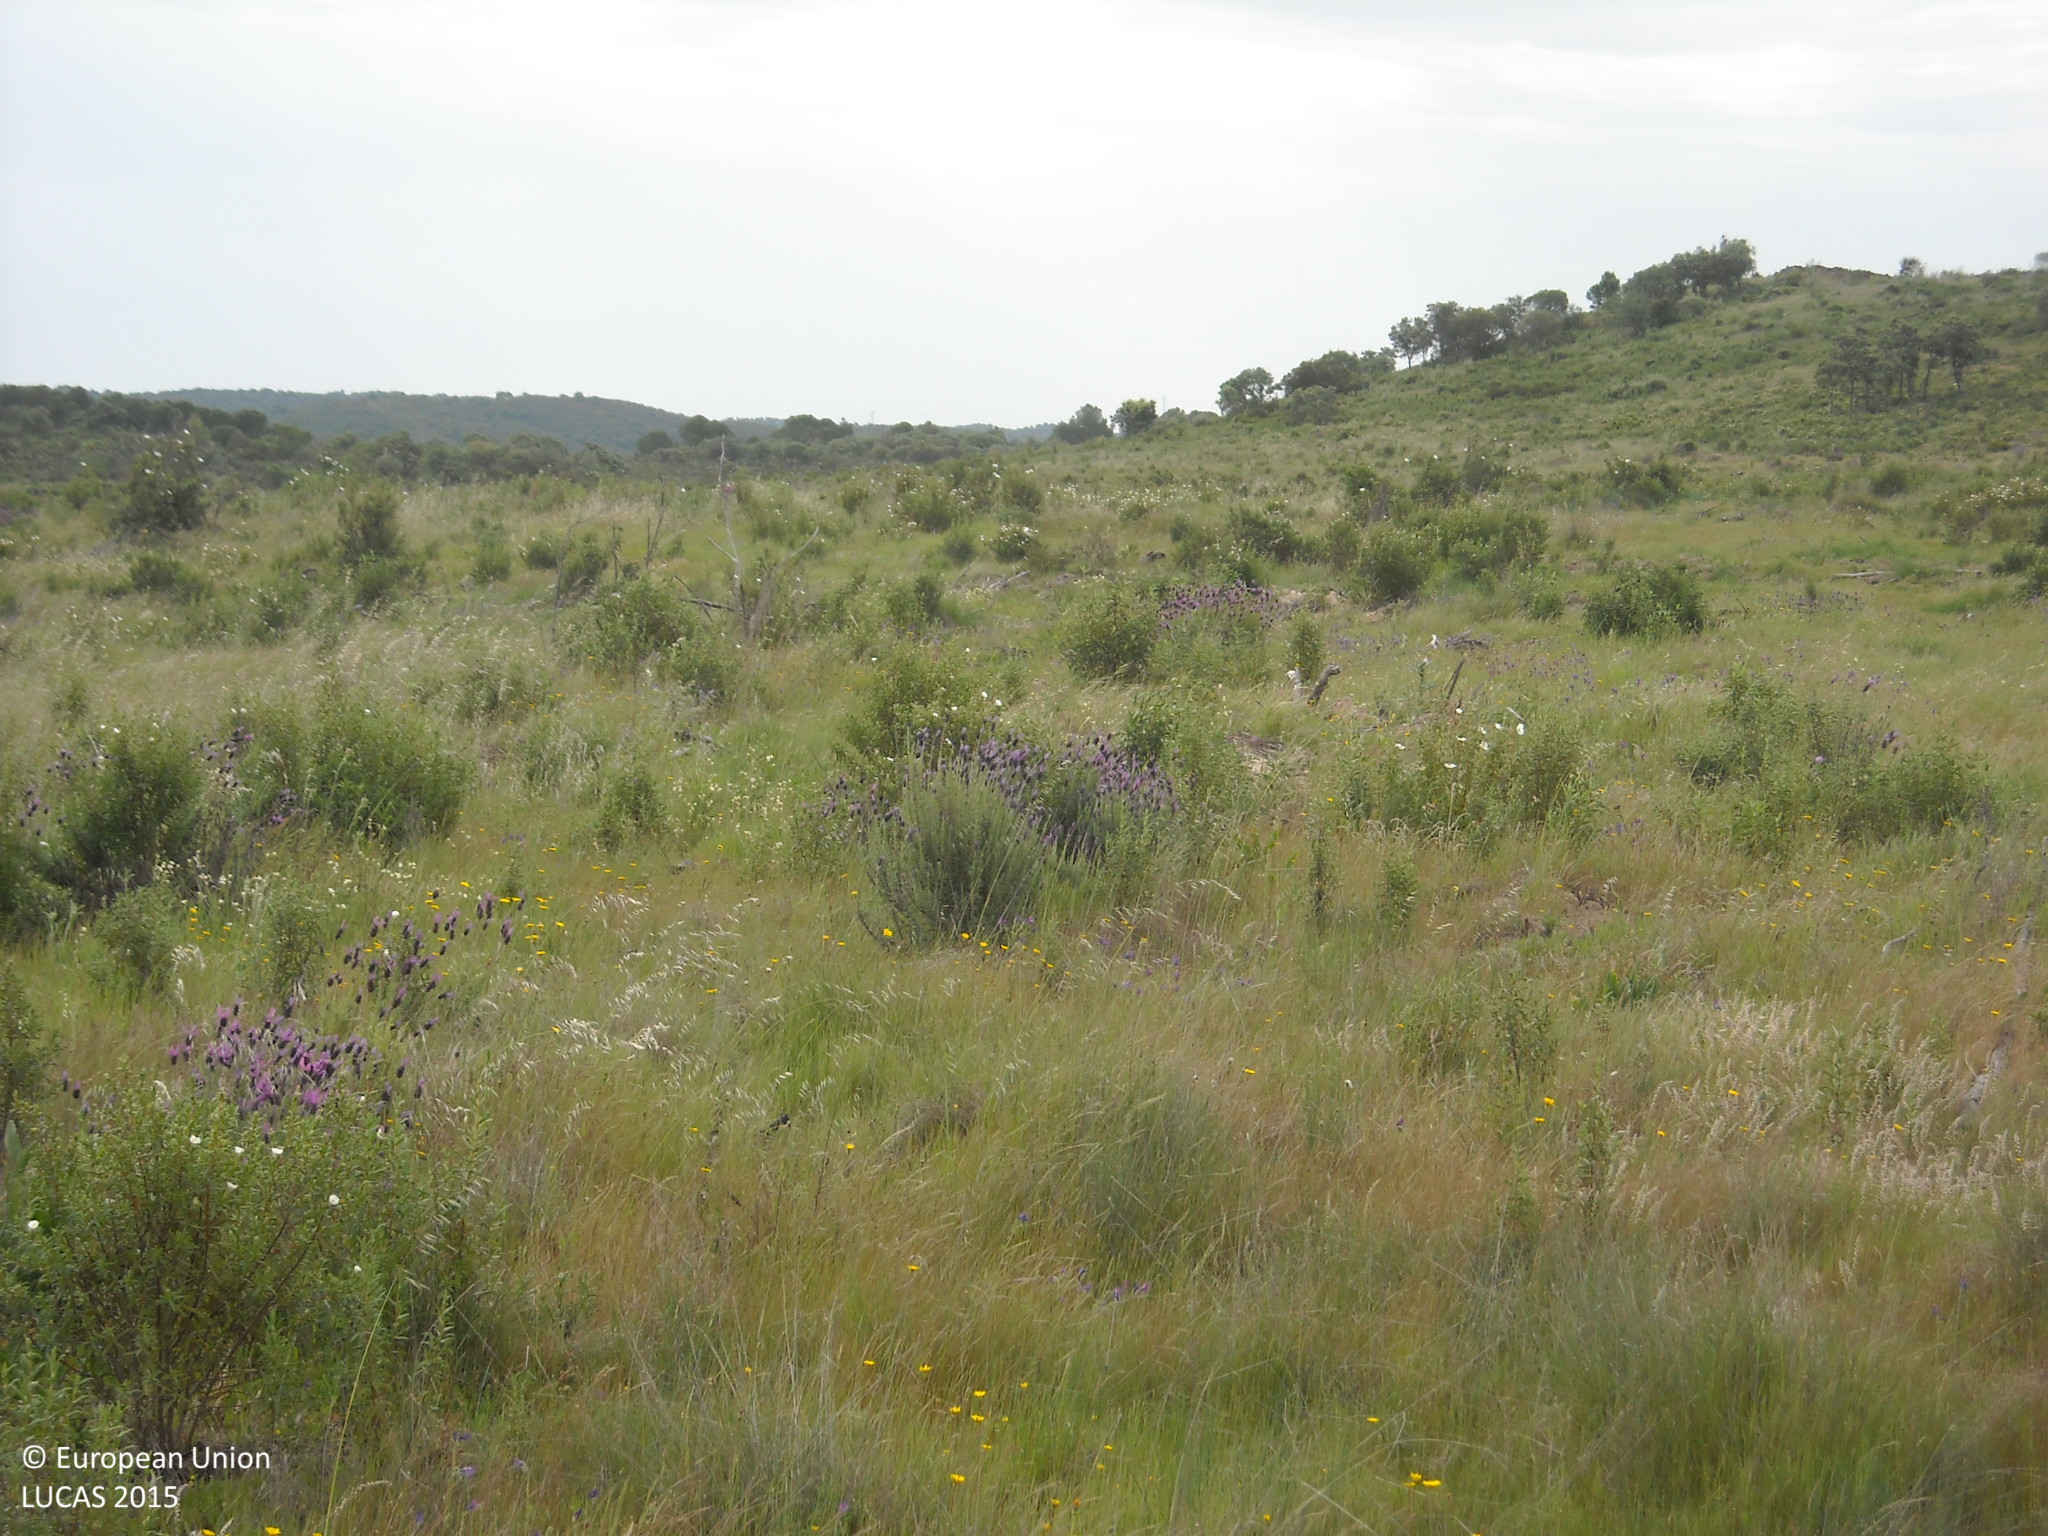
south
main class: Shrubland
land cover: Shrubland without tree cover
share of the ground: 10 - 25 %
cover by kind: herbaceous plants 80 %, shrubs 20 %
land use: Agriculture (excluding fallow land and kitchen gardens)
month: April
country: ES
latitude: 37.6351
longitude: -6.2257
